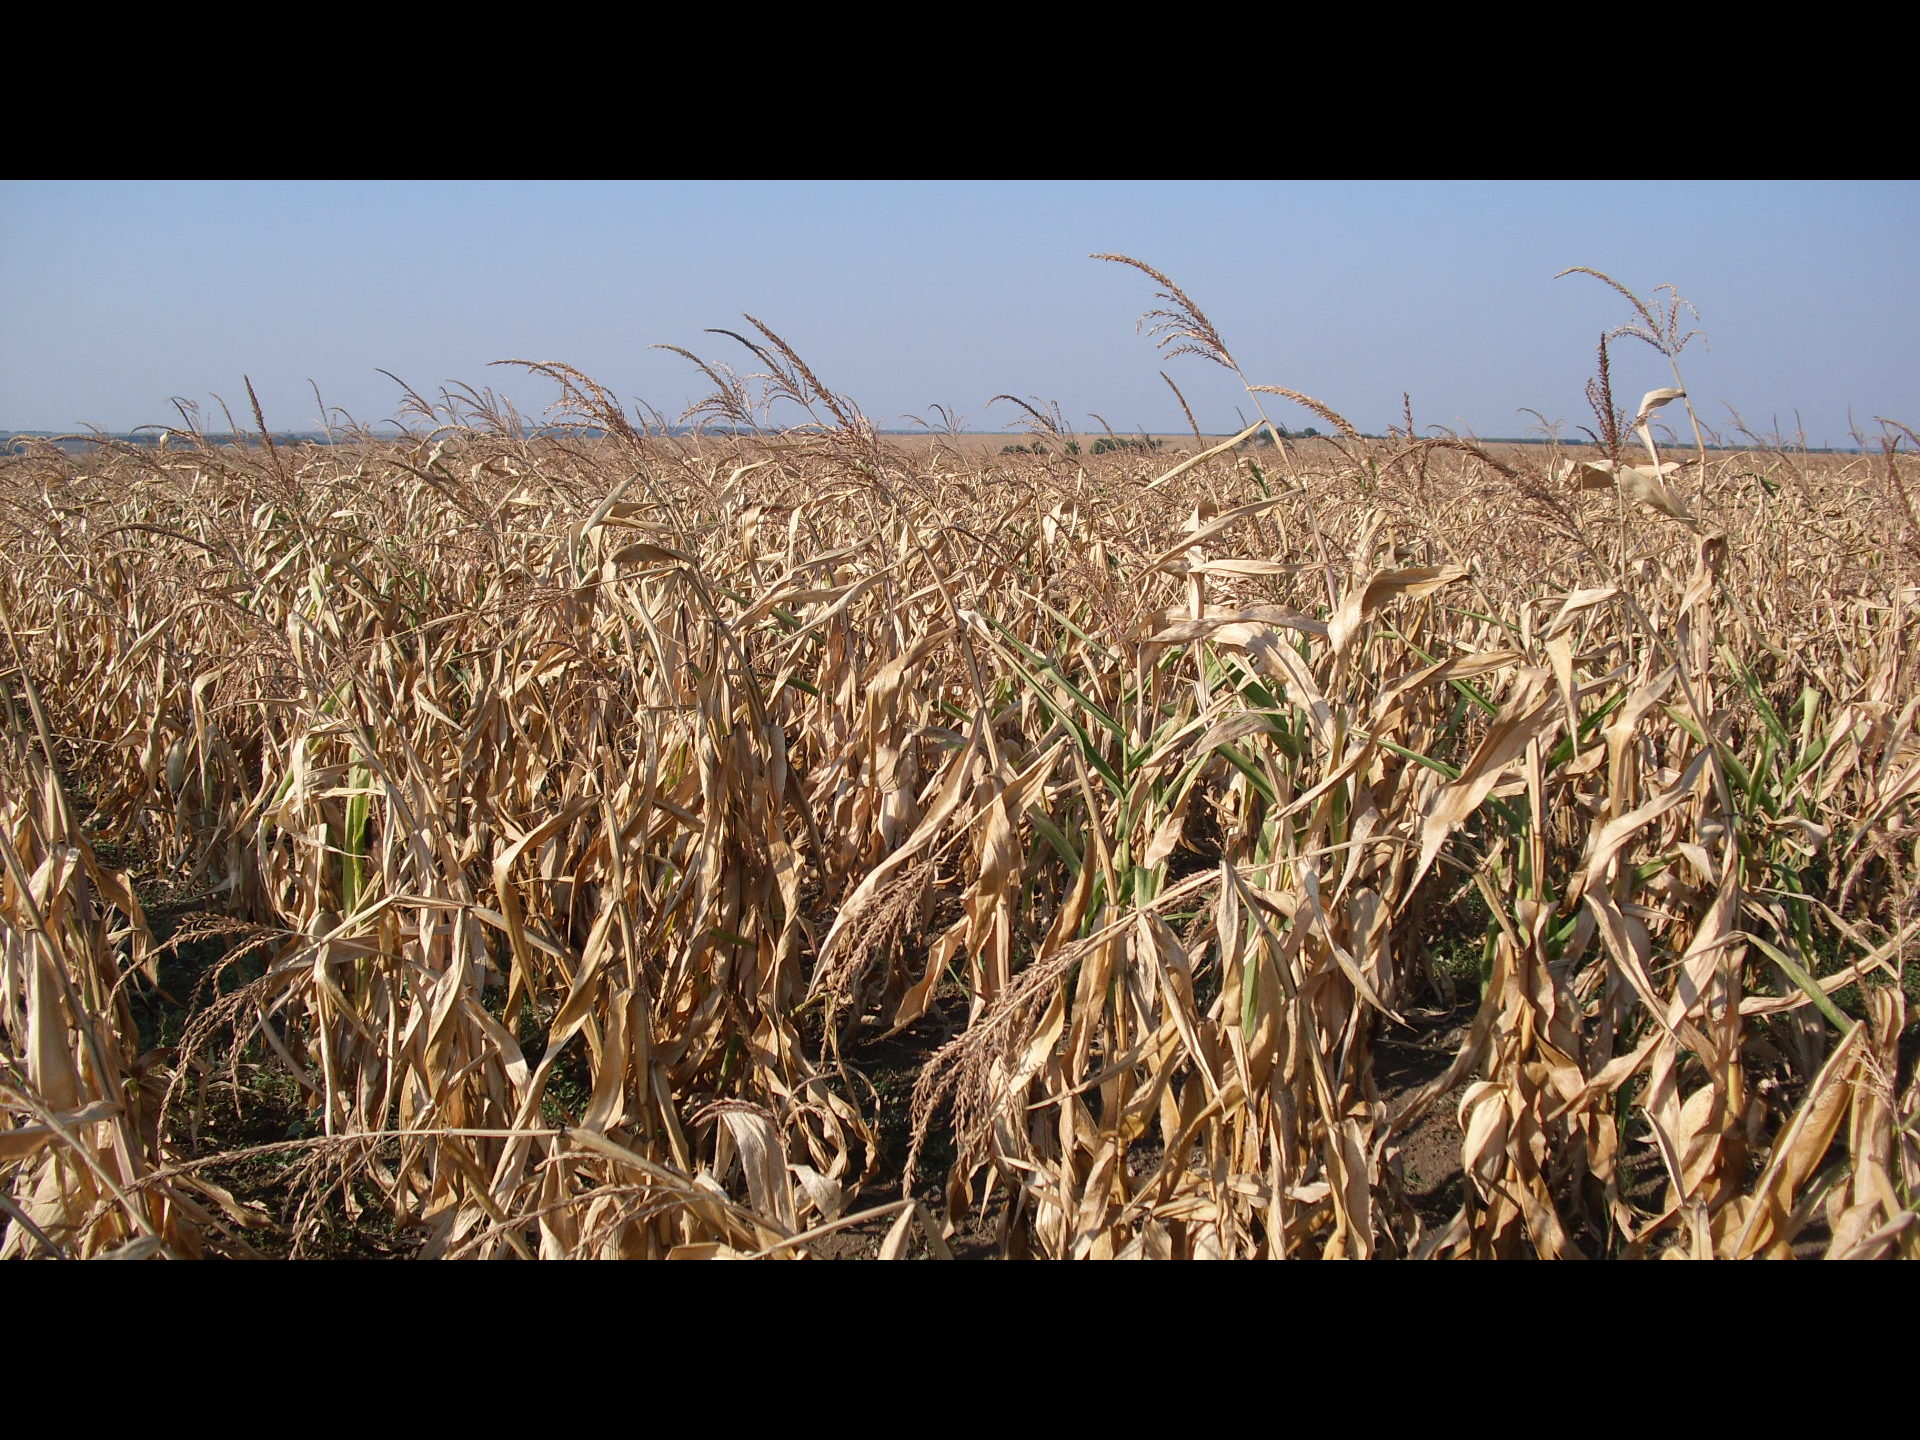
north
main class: Cropland
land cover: Maize
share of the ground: > 75 %
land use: Agriculture (excluding fallow land and kitchen gardens)
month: September
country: BG
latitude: 43.9669
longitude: 22.5613
